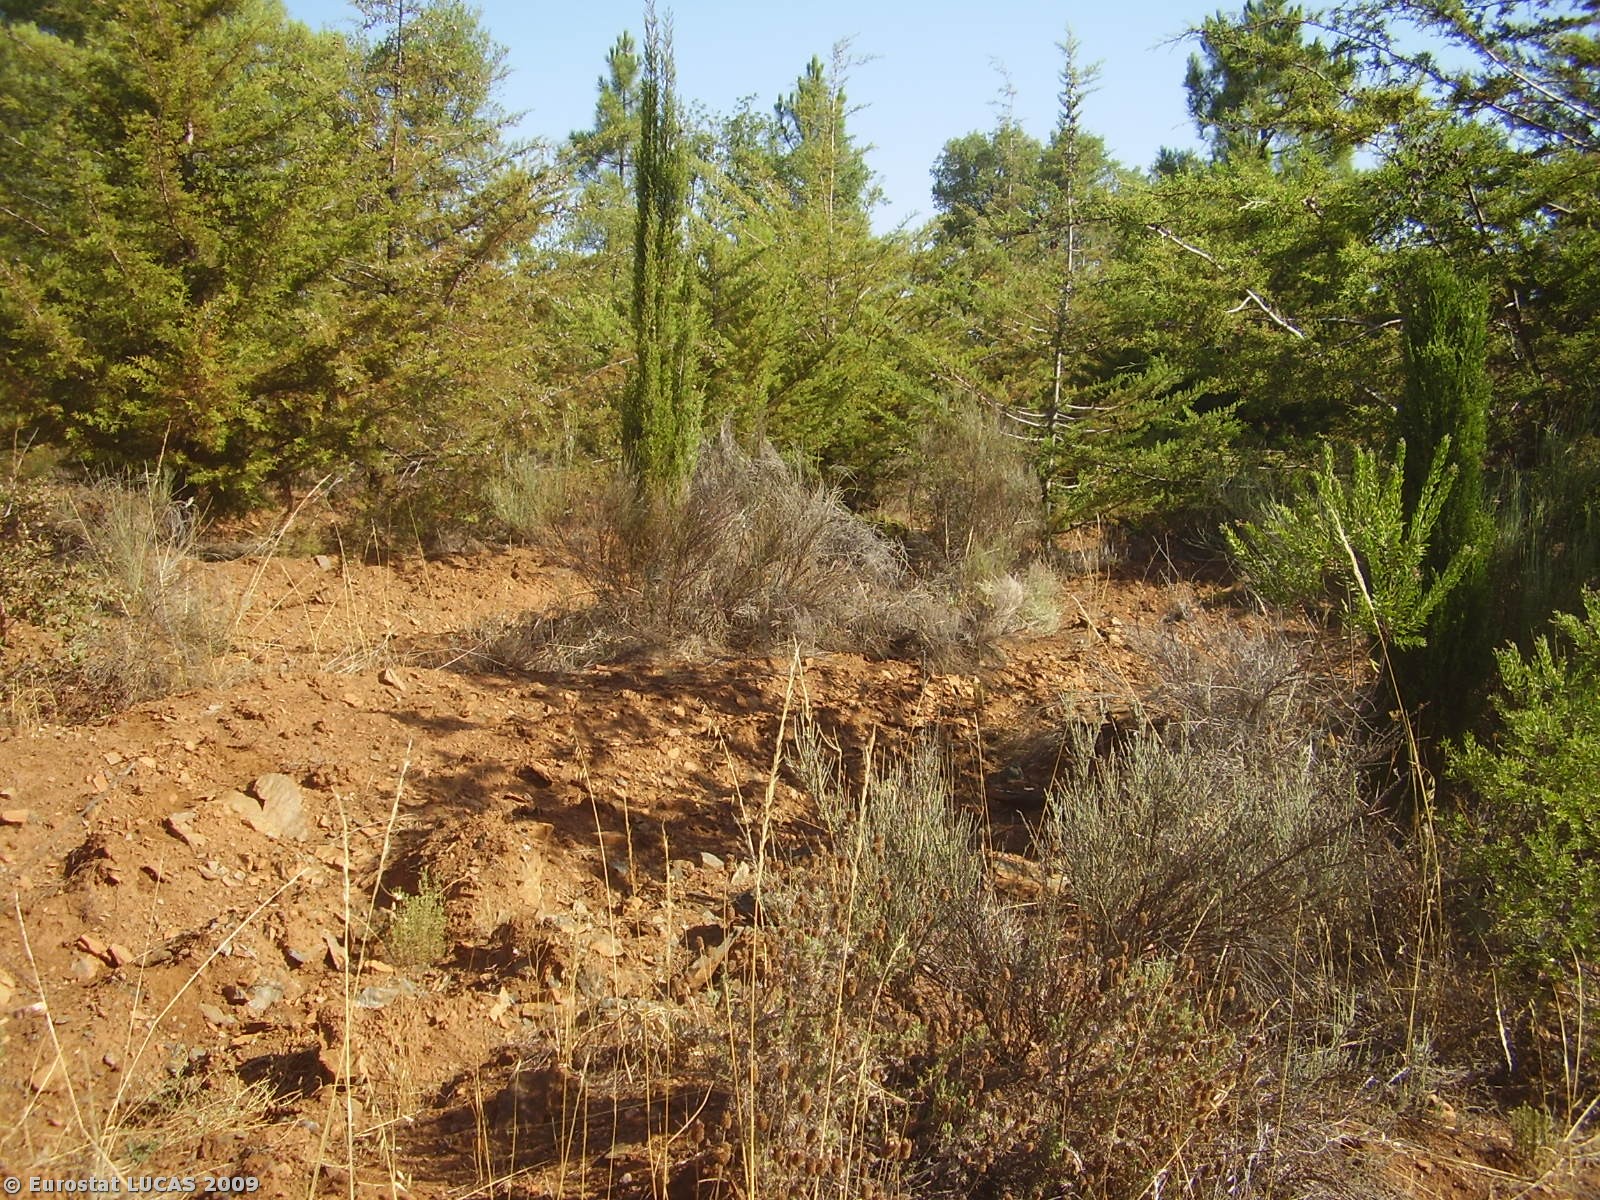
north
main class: Woodland
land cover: Coniferous woodland
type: coniferous forest of the mediterranean region
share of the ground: 25 - 50 %
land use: Forestry
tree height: > 5 m
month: August
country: PT
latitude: 41.4853
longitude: -6.8666
